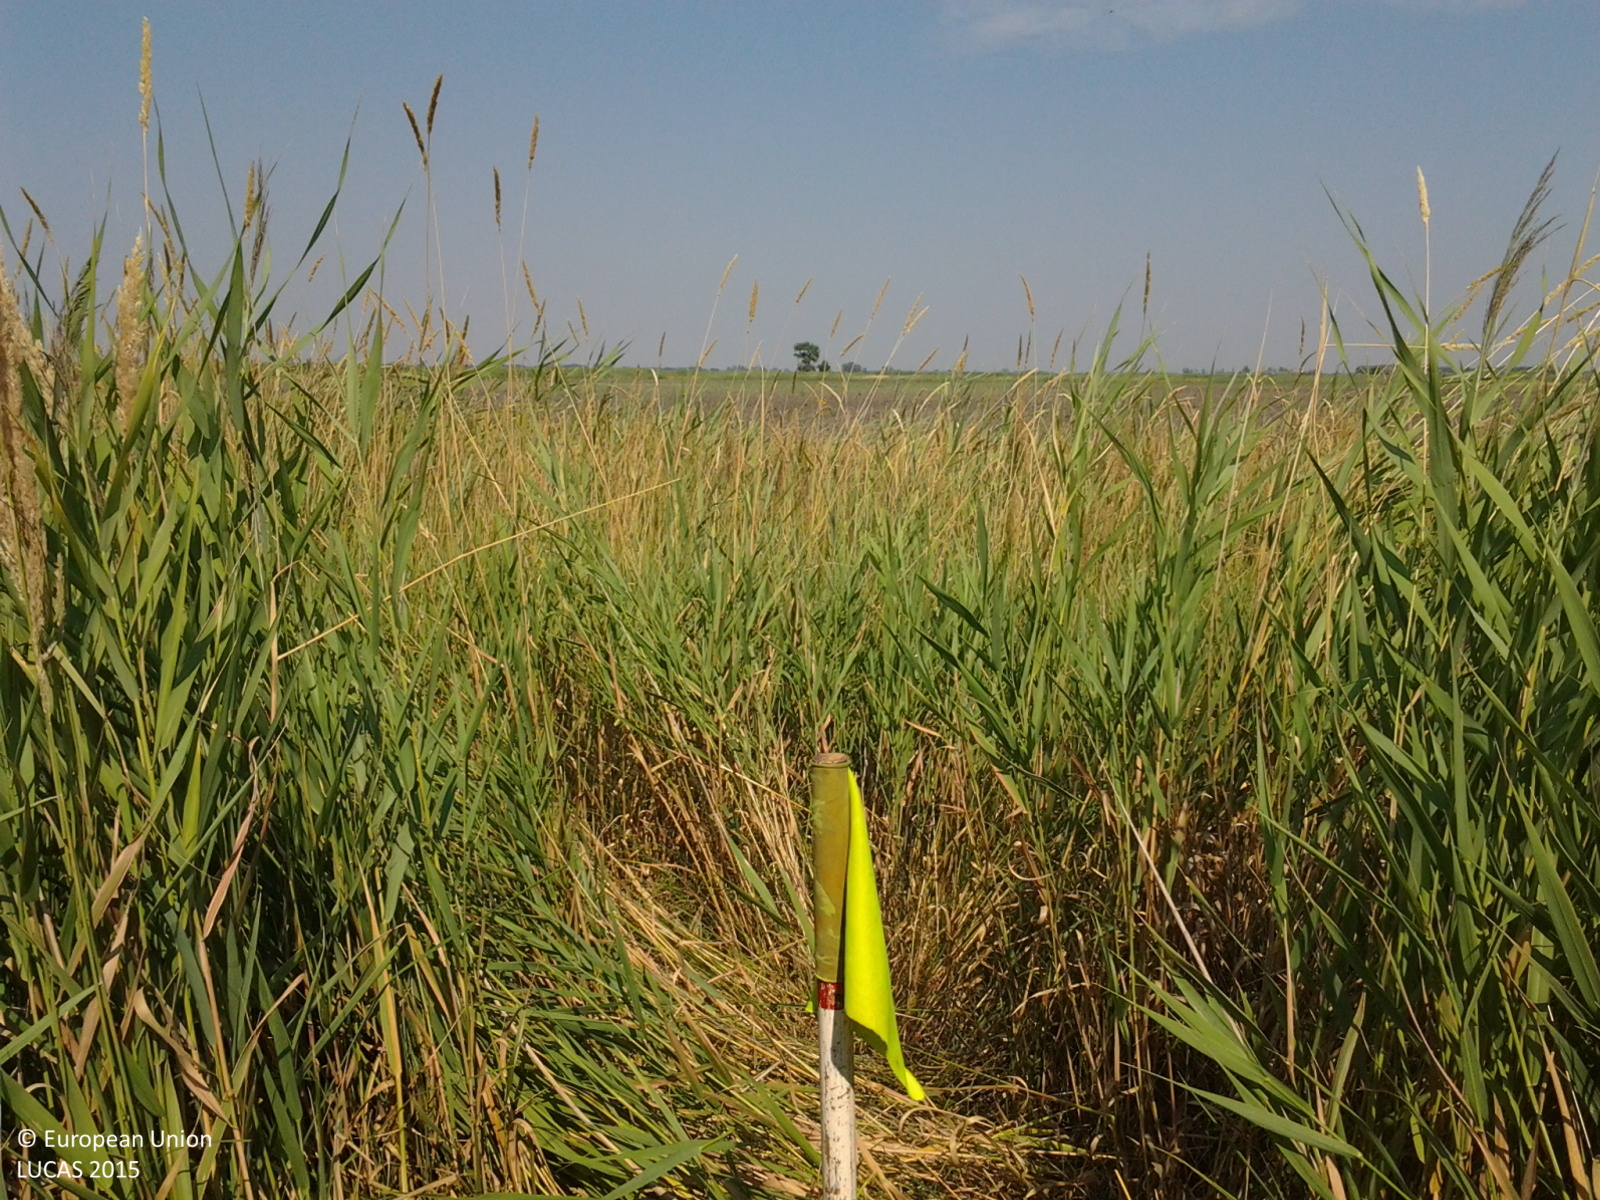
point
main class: Grassland
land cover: Spontaneously vegetated surfaces
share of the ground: > 75 %
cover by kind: herbaceous plants 100 %
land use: Semi-natural and natural areas not in use
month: July
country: HU
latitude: 47.2964
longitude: 20.5707
